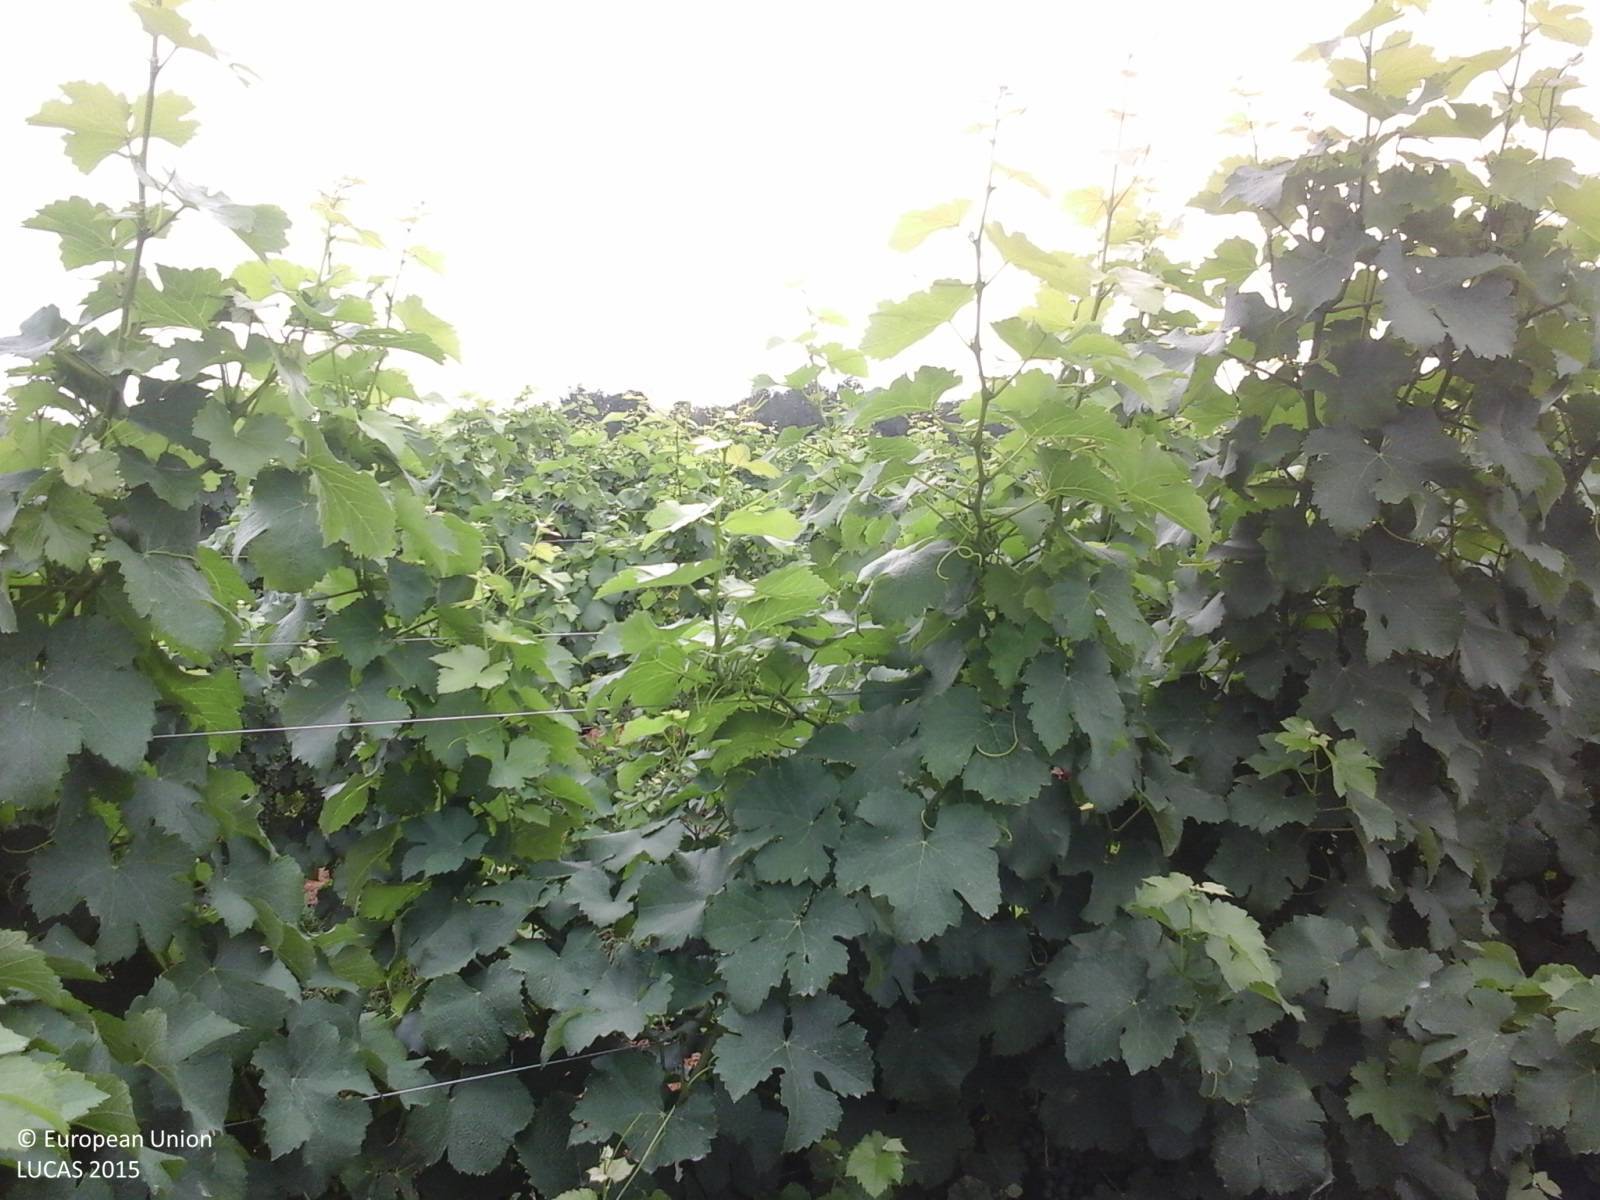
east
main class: Cropland
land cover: Vineyards
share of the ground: 50 - 75 %
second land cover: Grassland without tree/shrub cover
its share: > 75 %
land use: Agriculture (excluding fallow land and kitchen gardens)
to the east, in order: Vineyards; Grassland without tree/shrub cover; Tracks; Vineyards; Tracks; Other bare soil; Grassland with sparse tree/shrub cover; Grassland without tree/shrub cover; Broadleaved woodland
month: July
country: IT
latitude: 45.9838
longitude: 13.0299
